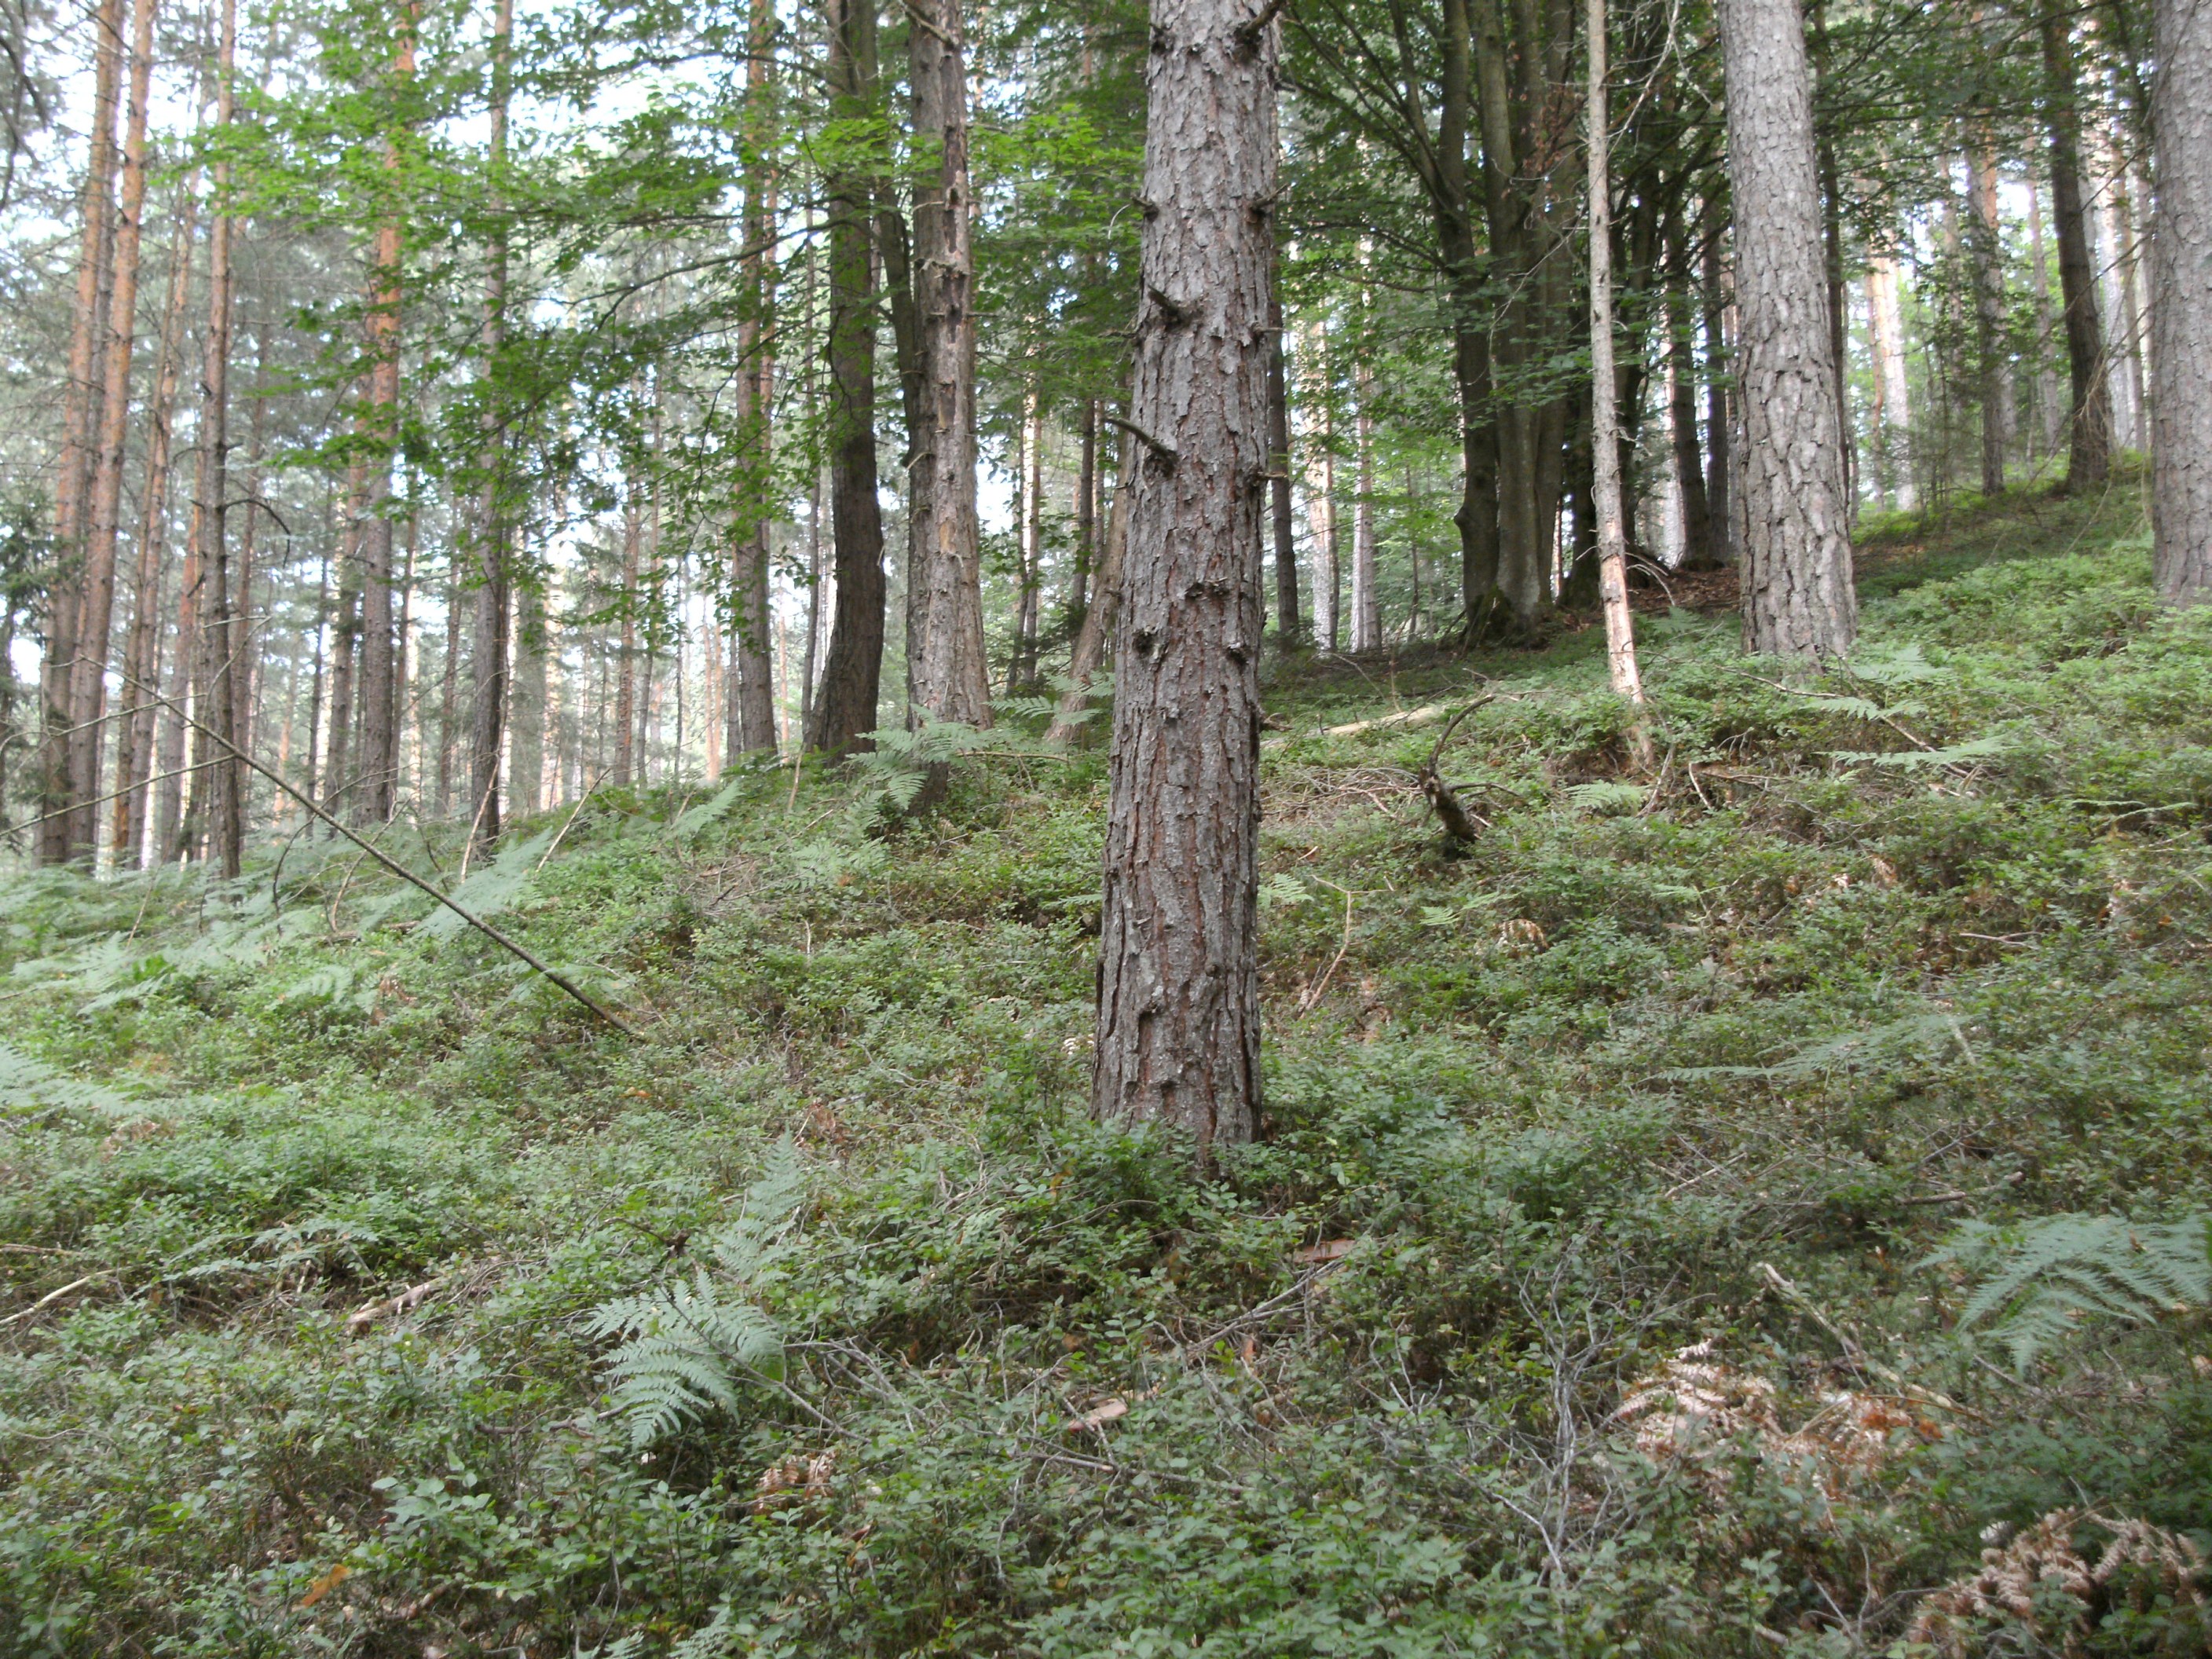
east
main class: Woodland
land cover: Pine dominated coniferous woodland
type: hemiboreal forest and nemoral coniferous forest and mixed broadleaved-coniferous forest
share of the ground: > 75 %
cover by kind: coniferous forest trees 70 %, broadleaved forest trees 10 %, shrubs 10 %, herbaceous plants 10 %
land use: Forestry
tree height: > 5 m
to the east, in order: Pine dominated coniferous woodland; Tracks; Pine dominated coniferous woodland; Tracks; Spruce dominated mixed woodland; Rivers and streams; Spruce dominated mixed woodland; Tracks
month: July
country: AT
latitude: 46.6216
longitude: 14.8168
